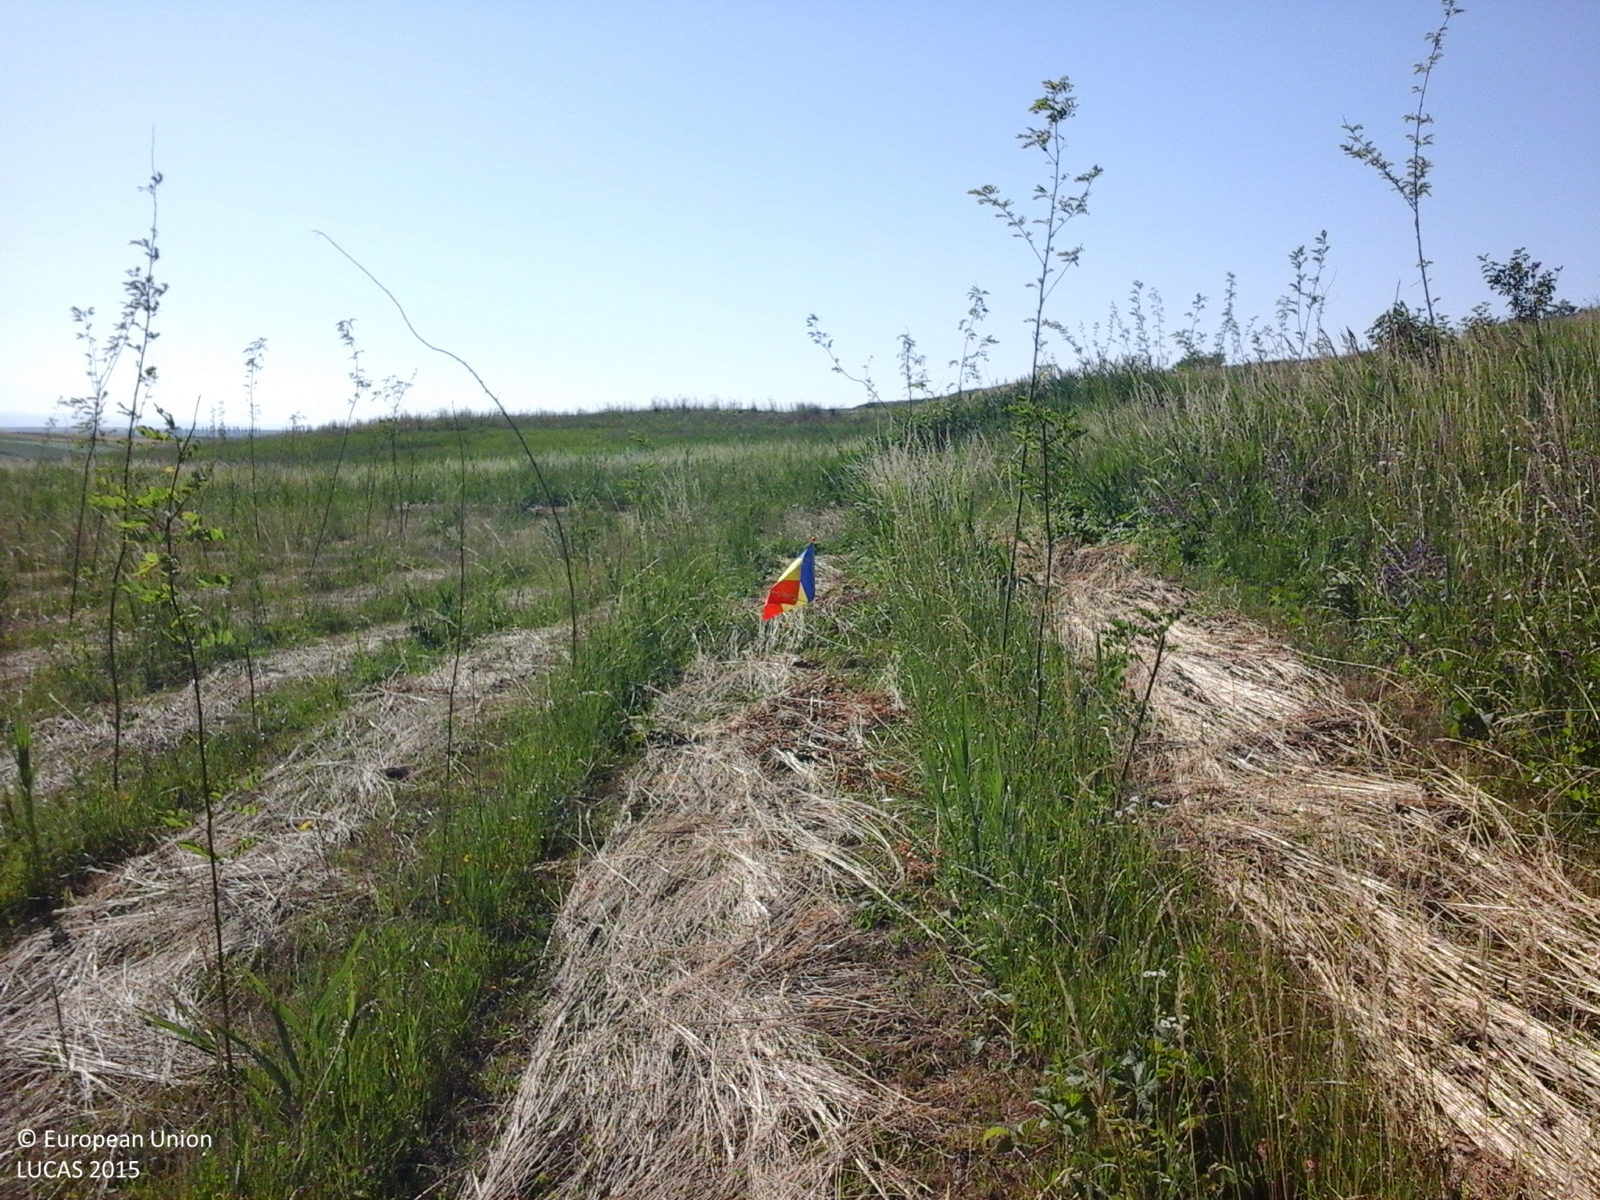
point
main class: Cropland
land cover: Nurseries
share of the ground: > 75 %
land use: Forestry
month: June
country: RO
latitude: 47.9926
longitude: 27.0048
